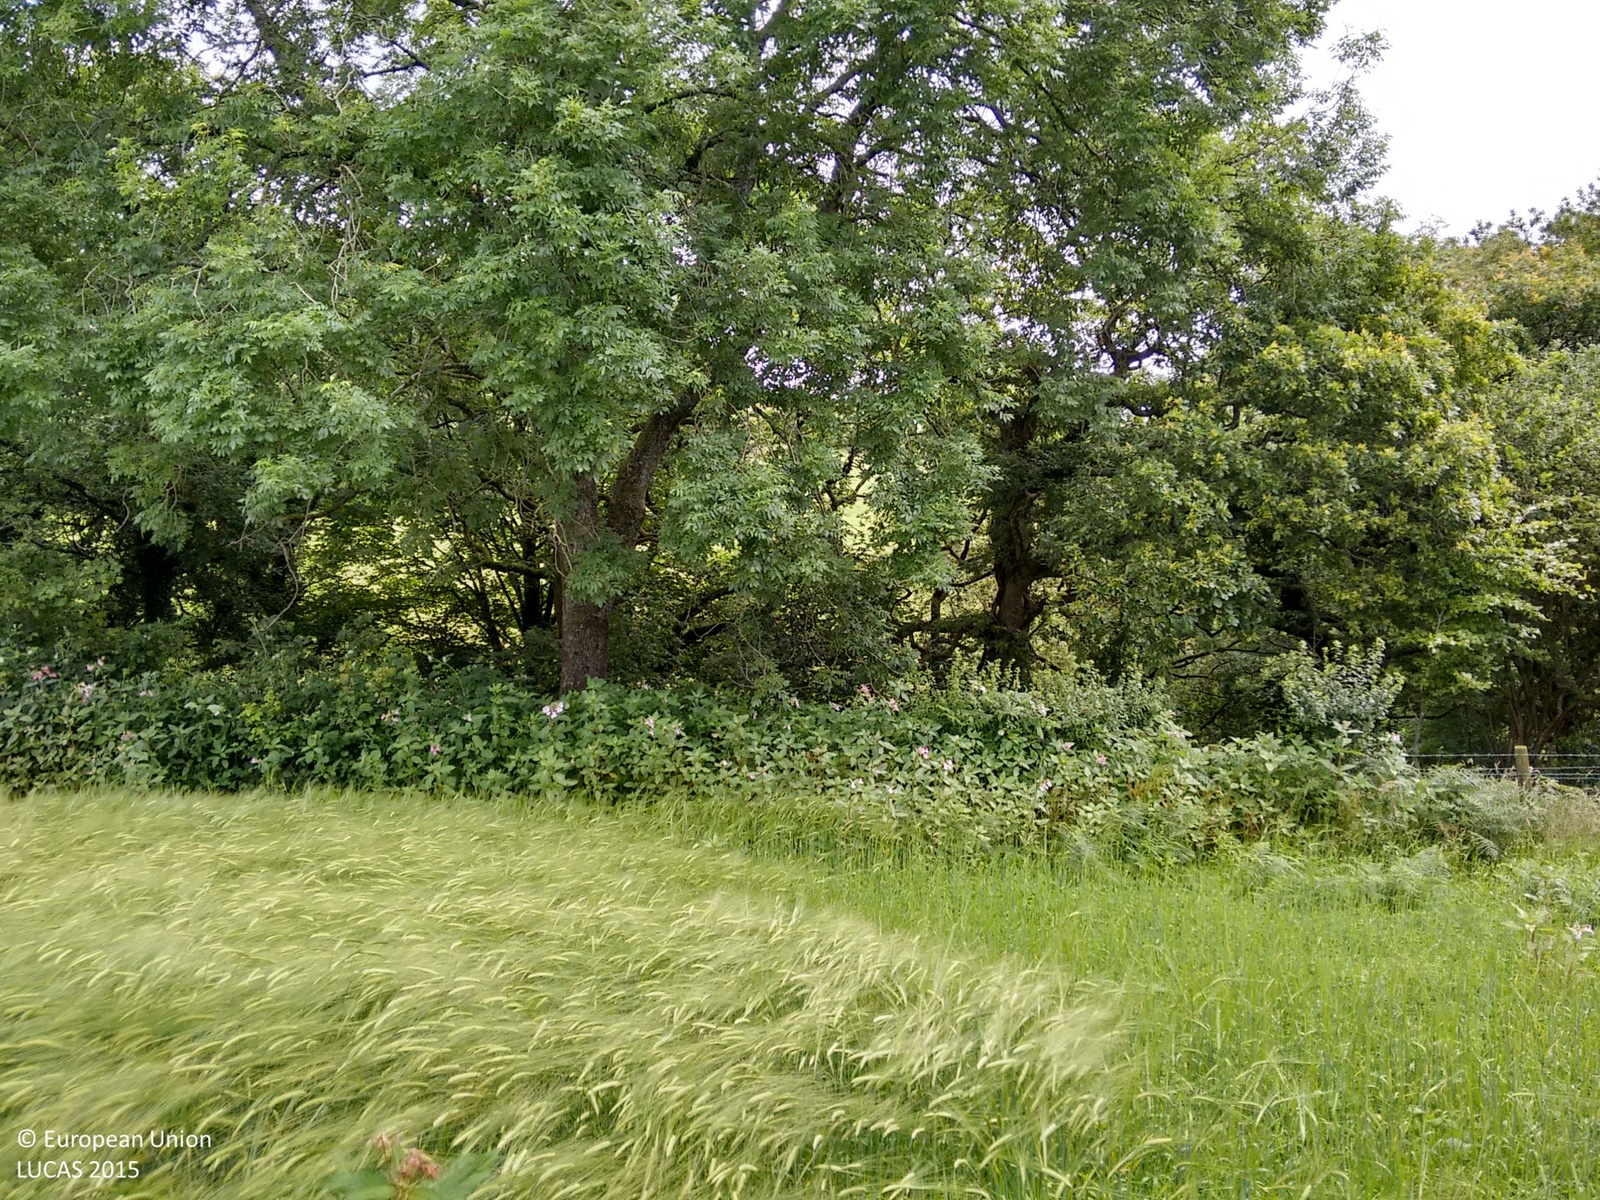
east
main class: Cropland
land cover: Barley
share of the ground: > 75 %
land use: Agriculture (excluding fallow land and kitchen gardens)
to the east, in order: Barley; Shruby margins; Fences; Broadleaved woodland; Fences; Broadleaved woodland; Rivers and streams; Broadleaved woodland; Fences; Shruby margins; Grassland without tree/shrub cover; Fences; Shruby margins; Electric lines; Fences; Barley
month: July
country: GB
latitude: 51.5501
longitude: -3.6286
